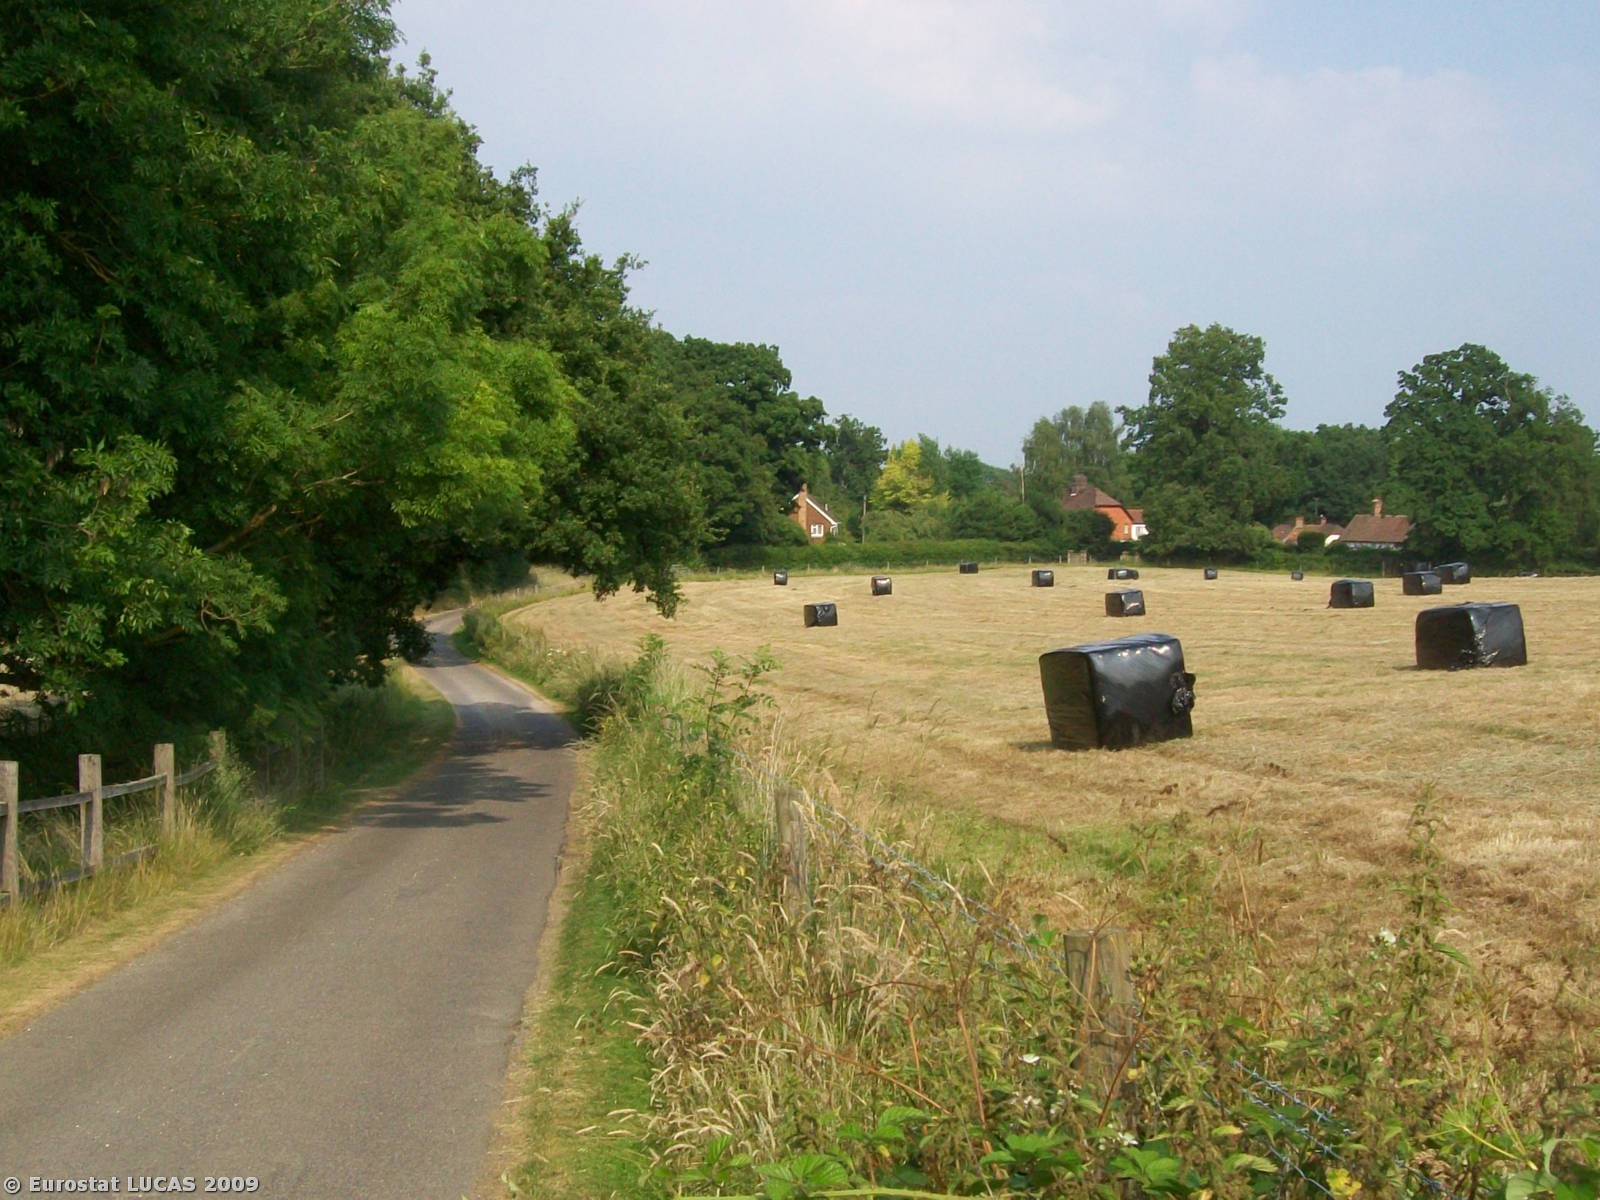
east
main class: Grassland
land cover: Grassland without tree/shrub cover
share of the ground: > 75 %
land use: Agriculture (excluding fallow land and kitchen gardens)
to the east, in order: Grassland without tree/shrub cover; Fences; Paved roads, cycling and walking lanes; Managed hedges; Artificial constructions in urban areas
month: July
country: GB
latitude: 51.1166
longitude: -0.6544
